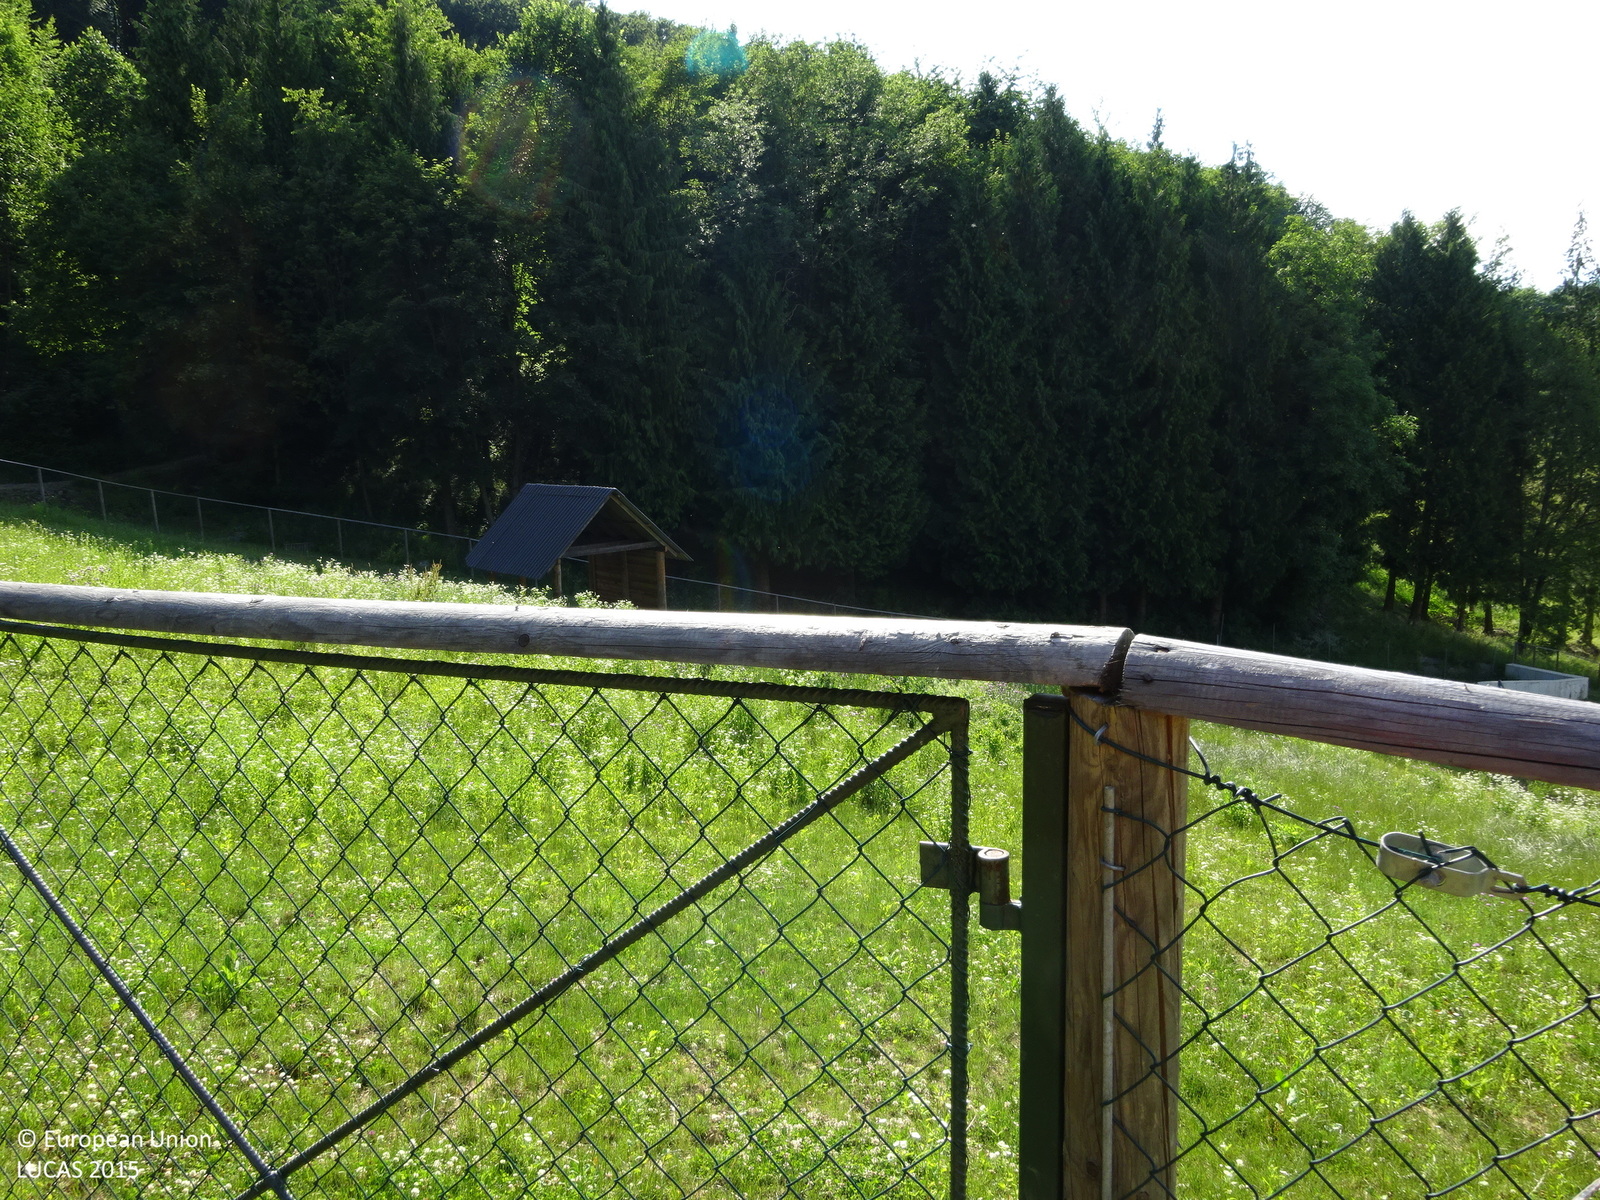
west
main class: Grassland
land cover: Grassland without tree/shrub cover
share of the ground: > 75 %
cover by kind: herbaceous plants 100 %
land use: Agriculture (excluding fallow land and kitchen gardens)
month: June
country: AT
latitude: 46.6914
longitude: 15.6090
